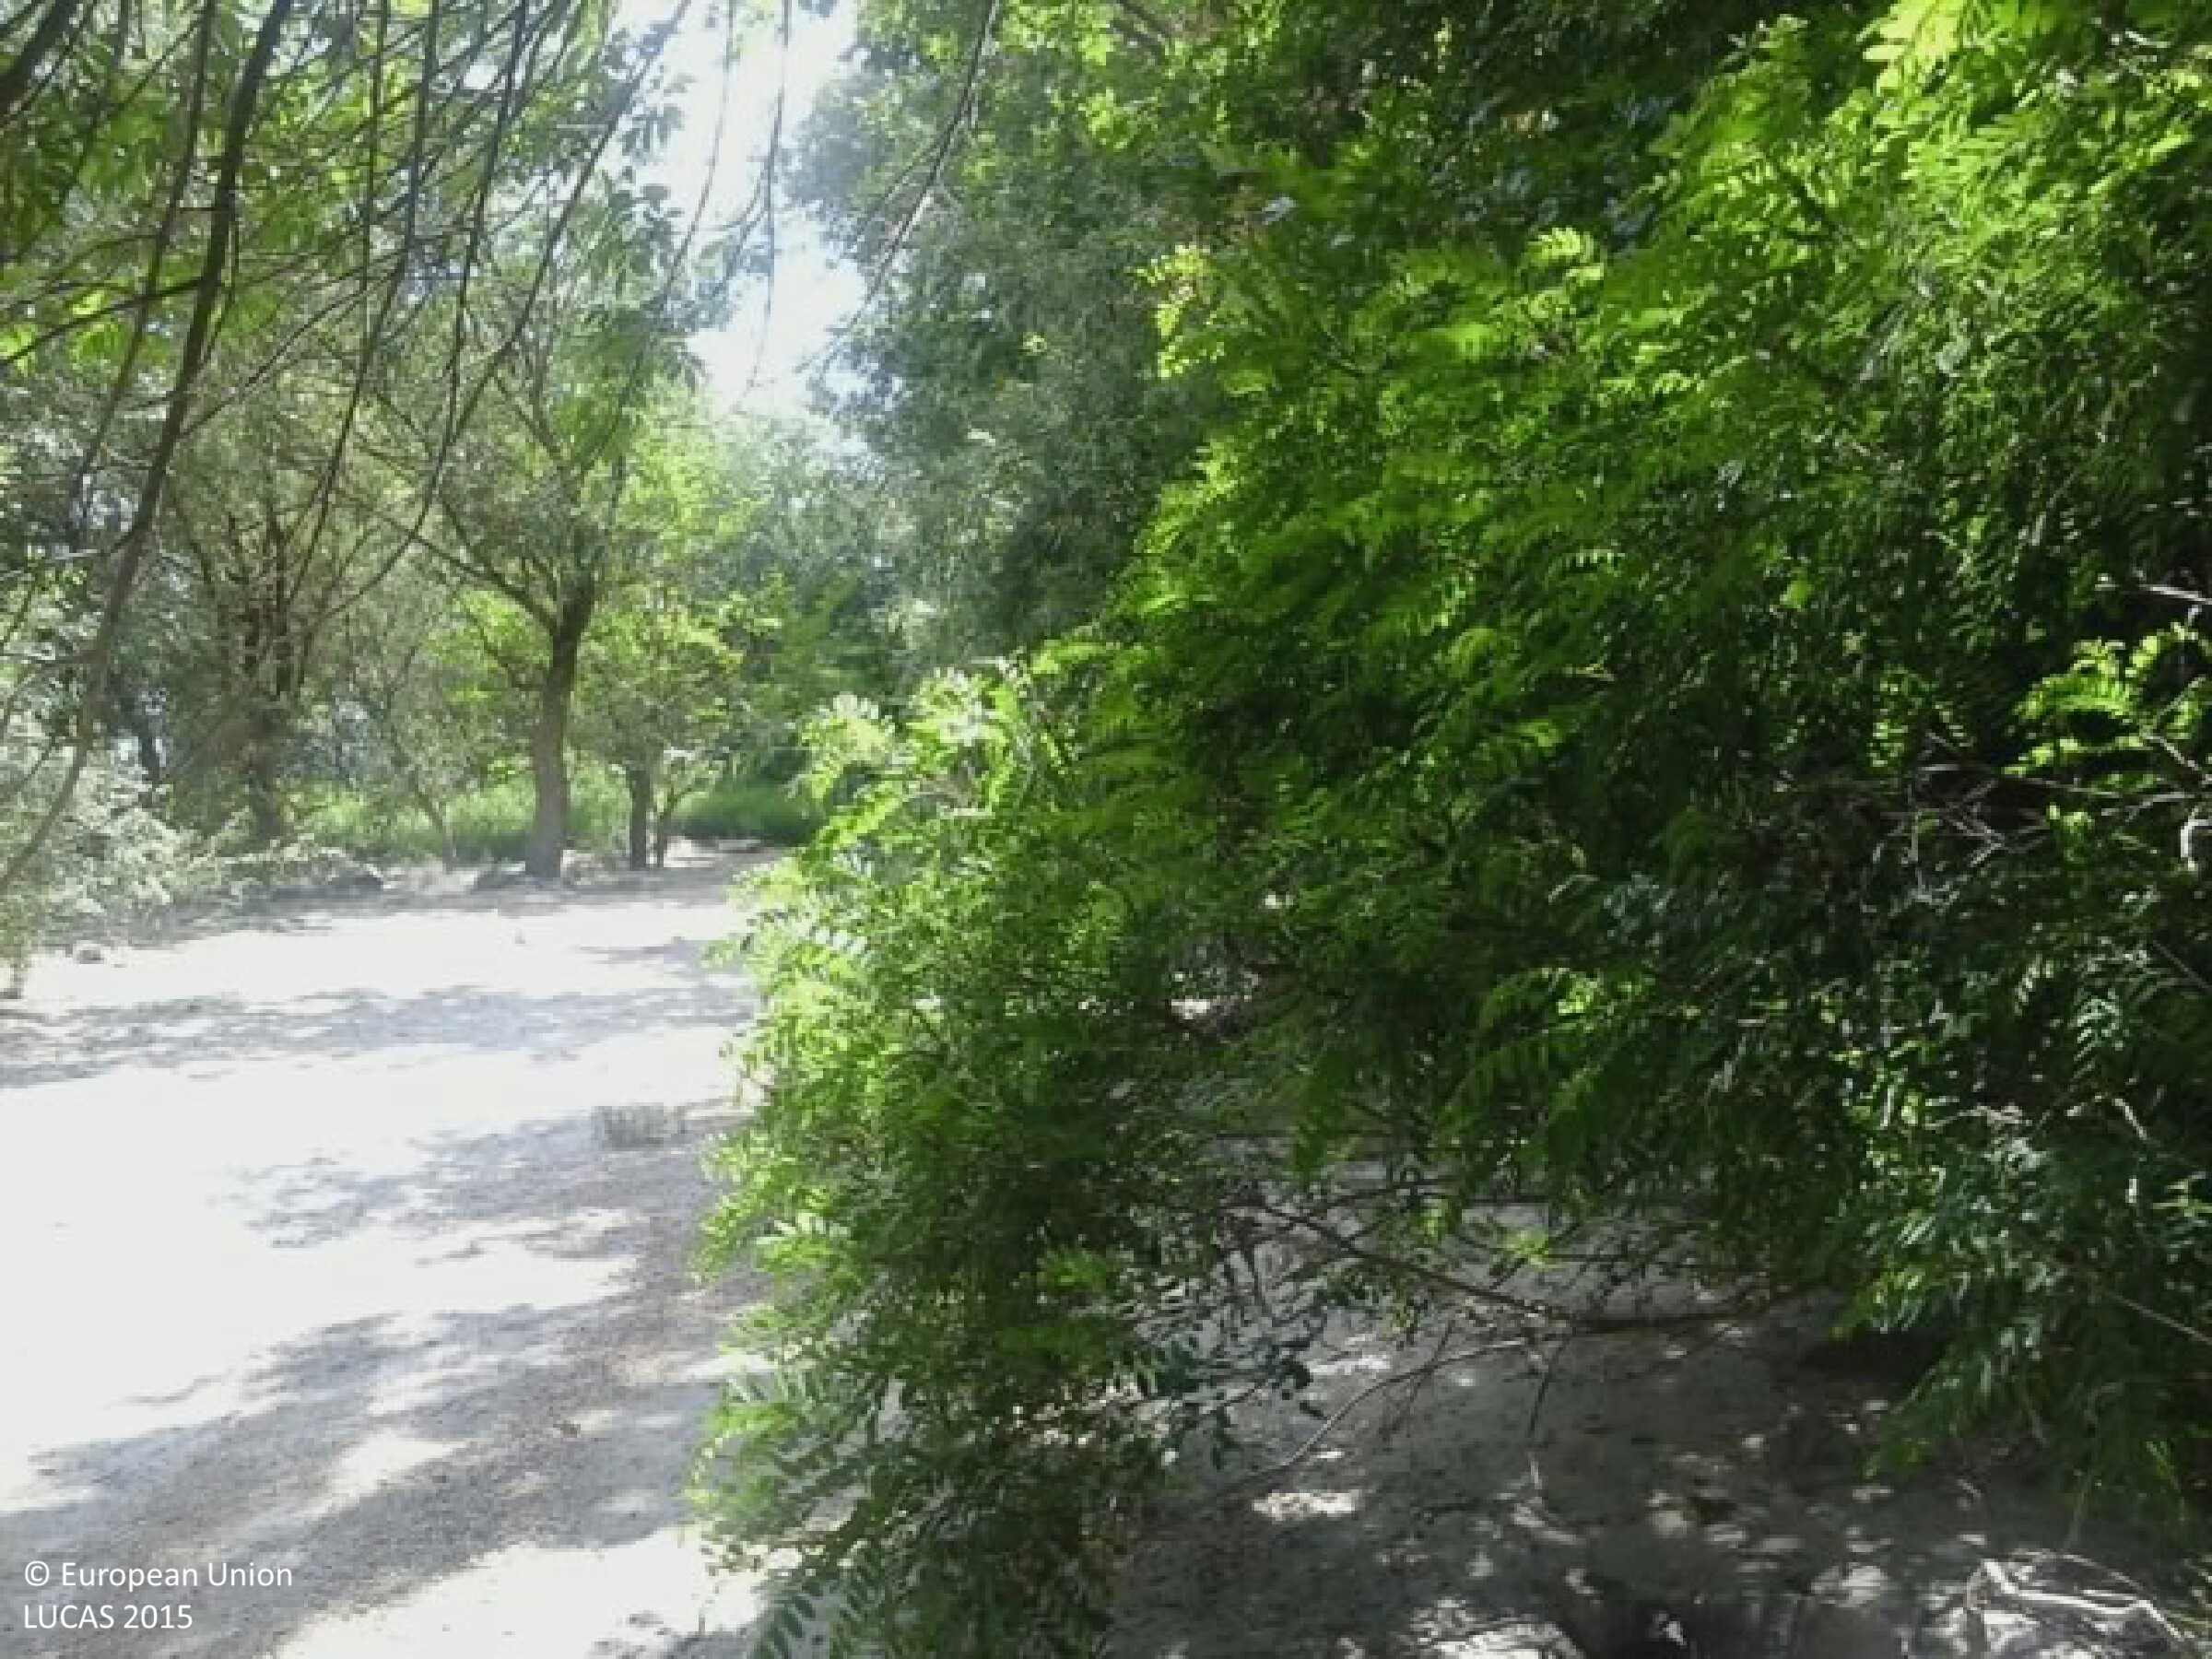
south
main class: Woodland
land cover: Broadleaved woodland
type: mesophytic deciduous forest
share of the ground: > 75 %
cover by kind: broadleaved forest trees 75 %, unconsolidated bare surface 20 %, herbaceous plants 5 %
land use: Semi-natural and natural areas not in use
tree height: > 5 m
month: June
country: HU
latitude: 46.8653
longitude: 18.9218
